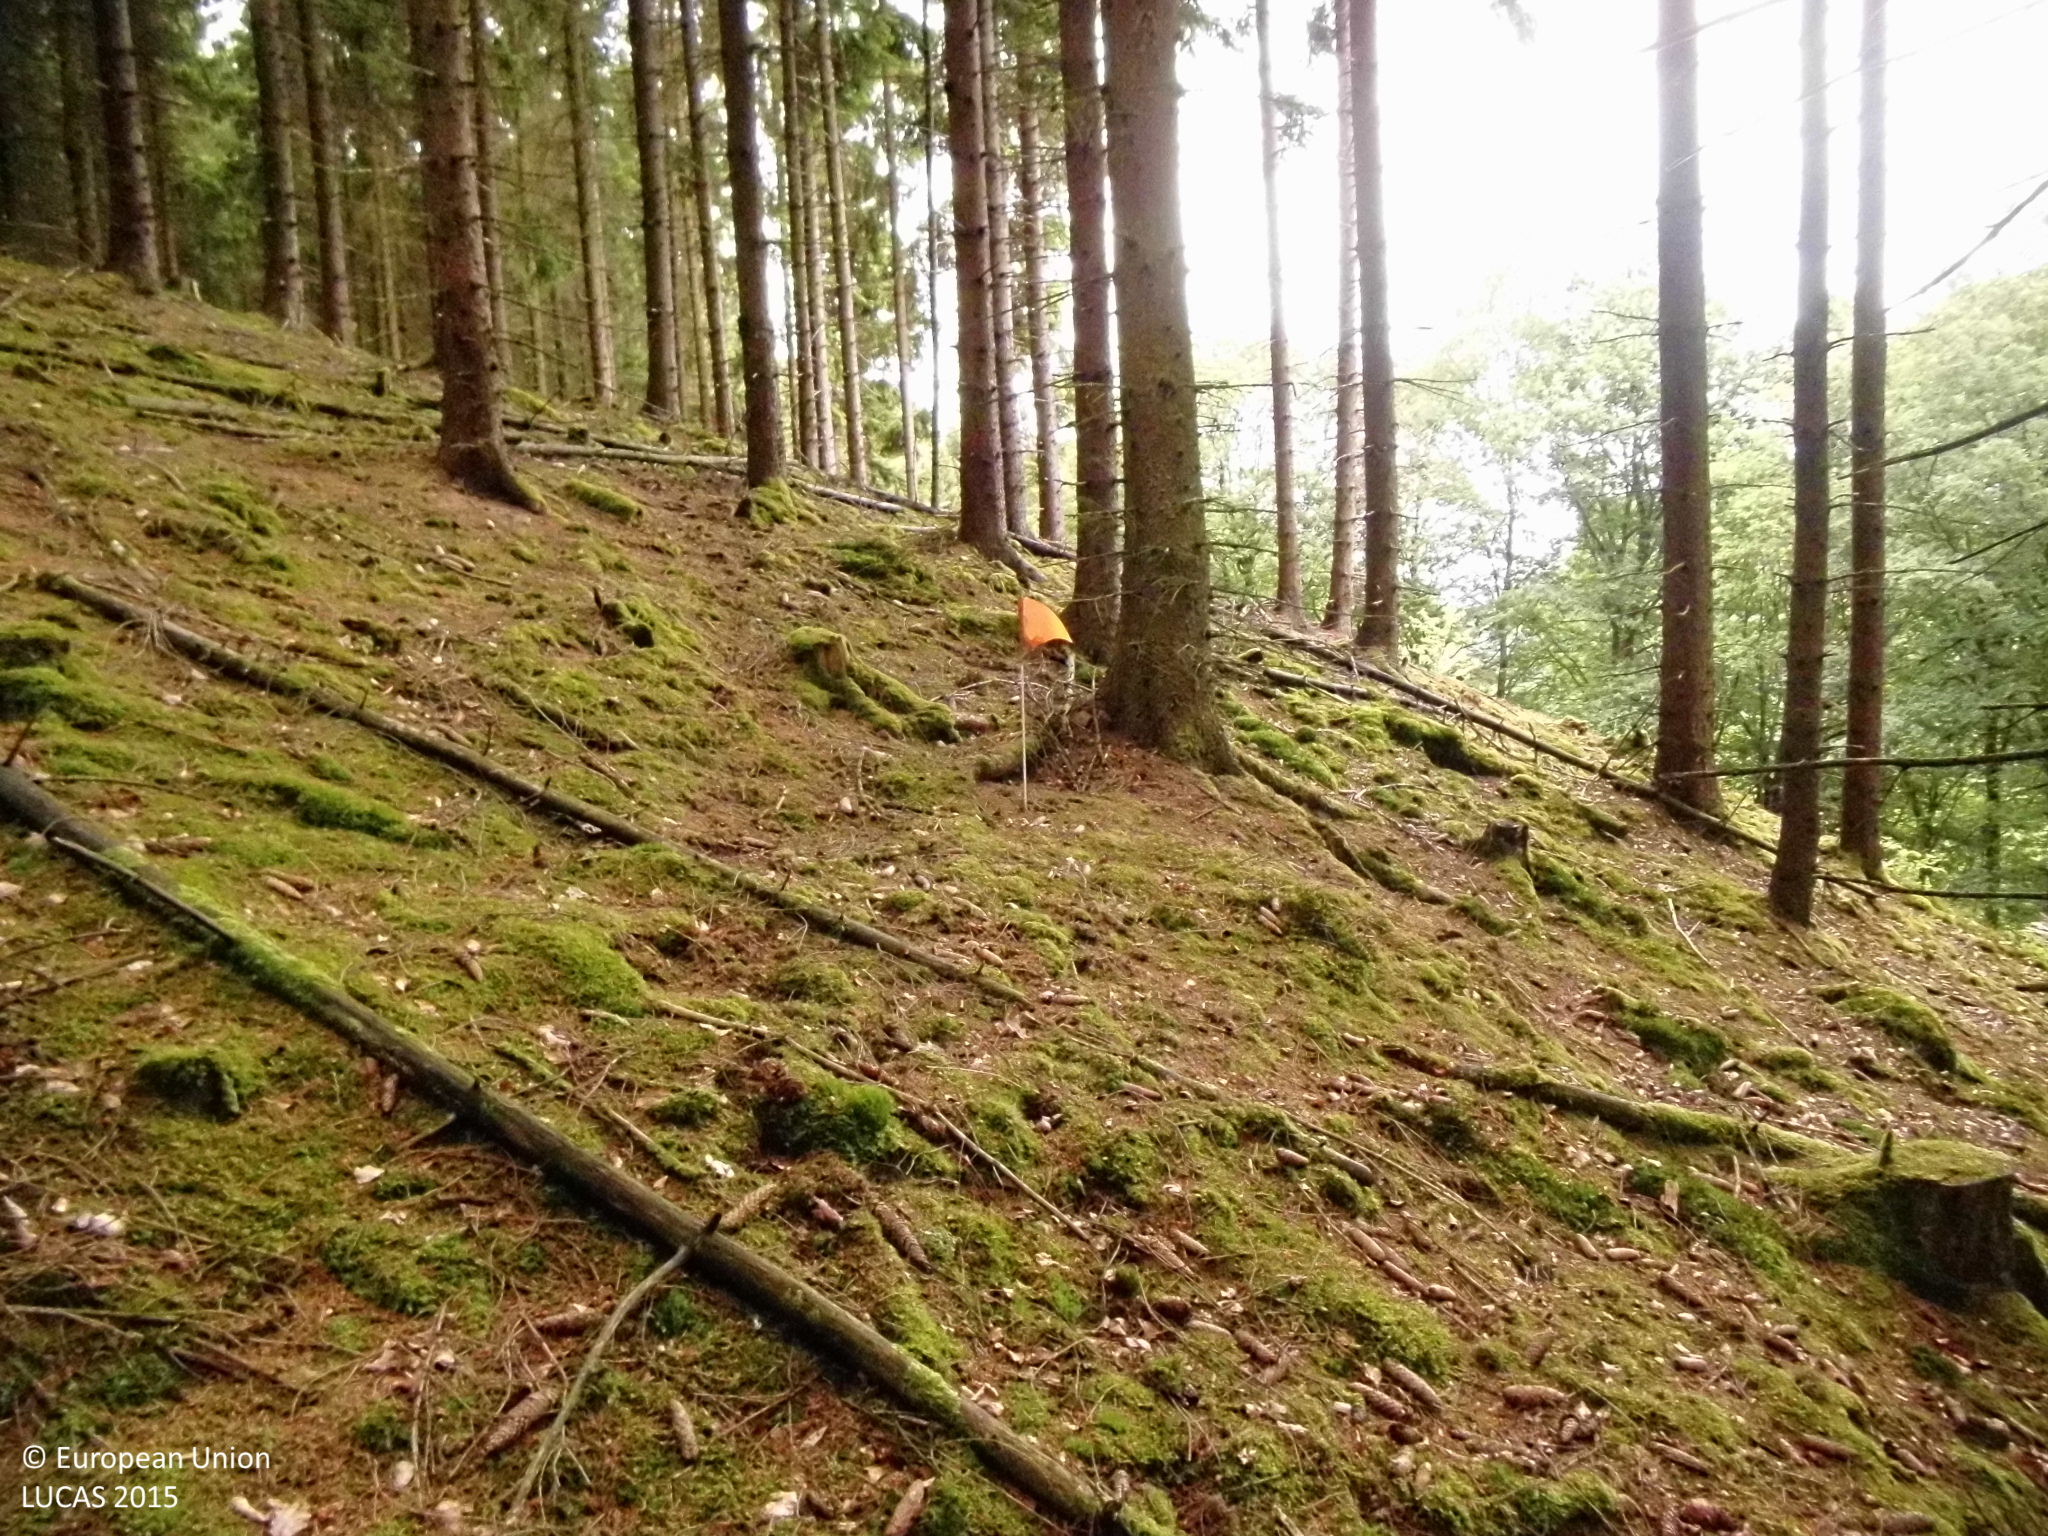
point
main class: Woodland
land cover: Spruce dominated coniferous woodland
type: hemiboreal forest and nemoral coniferous forest and mixed broadleaved-coniferous forest
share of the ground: > 75 %
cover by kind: coniferous forest trees 85 %, lichens and mosses 10 %, unconsolidated bare surface 5 %
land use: Forestry
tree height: > 5 m
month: July
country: DE
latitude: 50.7603
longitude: 8.0015
